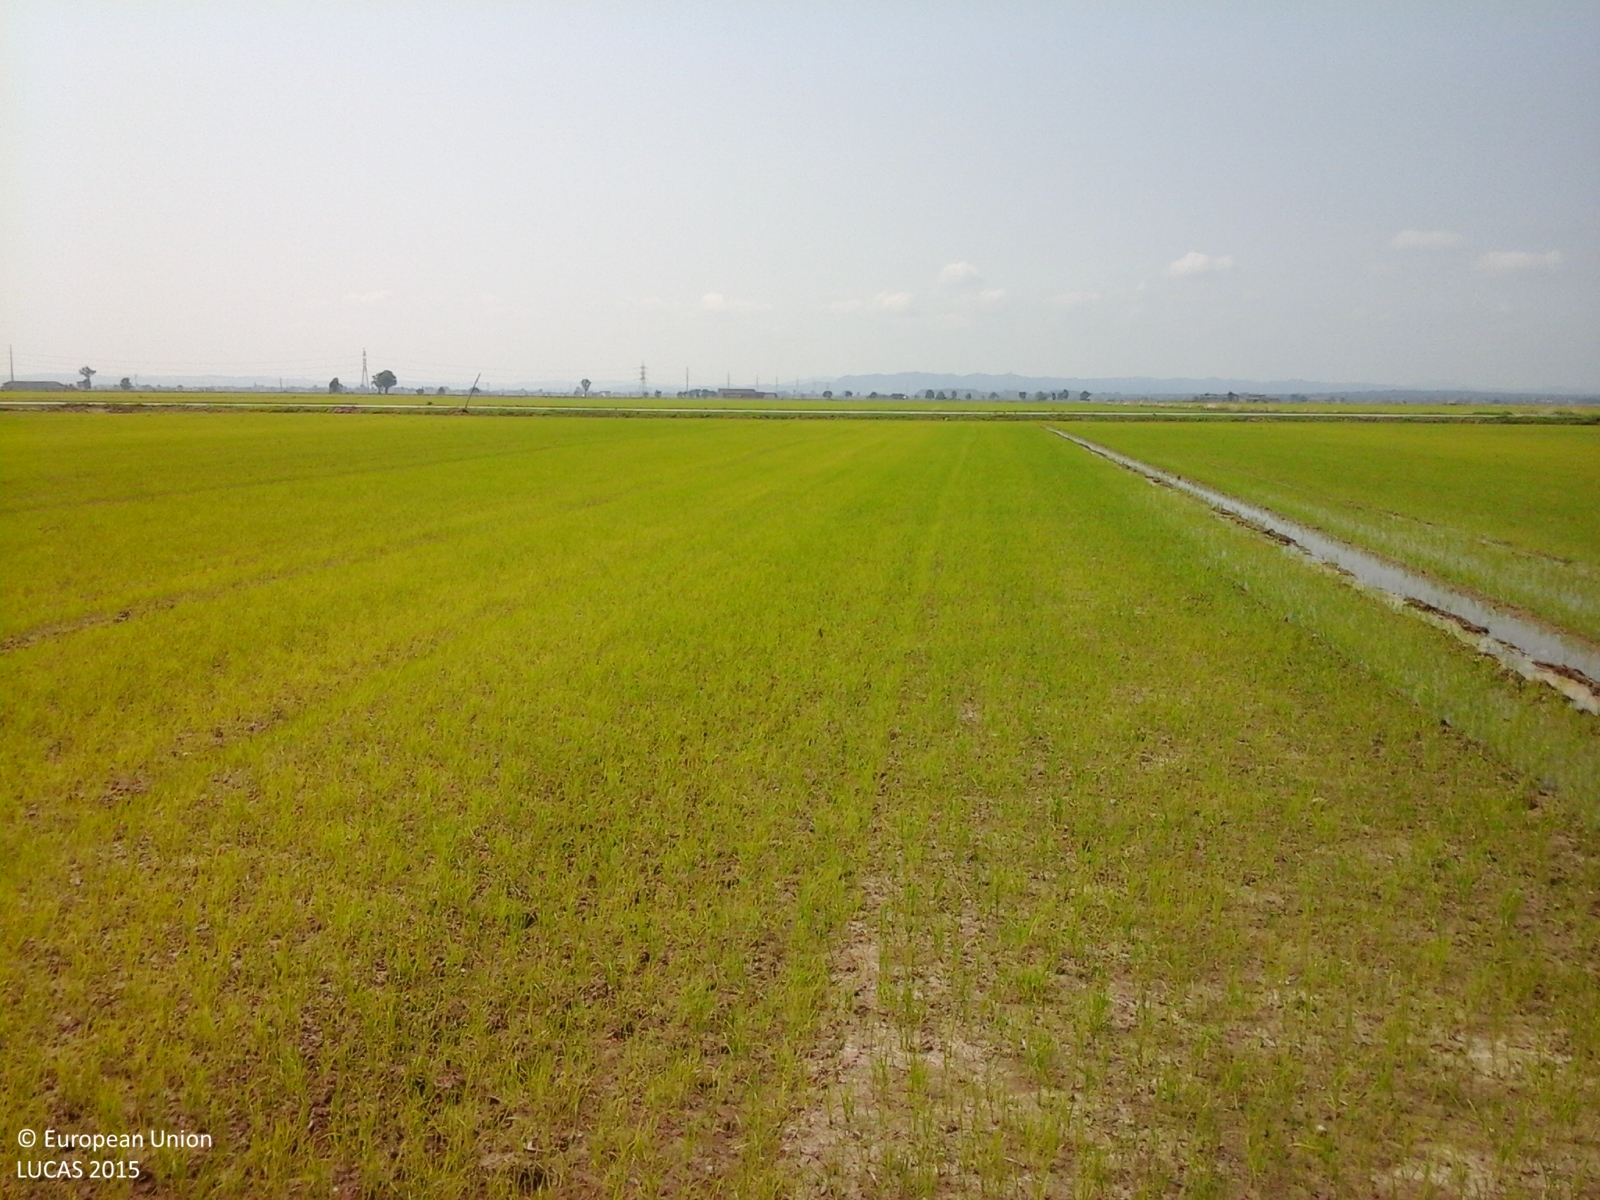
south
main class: Cropland
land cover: Rice
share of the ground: 50 - 75 %
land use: Agriculture (excluding fallow land and kitchen gardens)
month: May
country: IT
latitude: 45.2925
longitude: 8.3071
